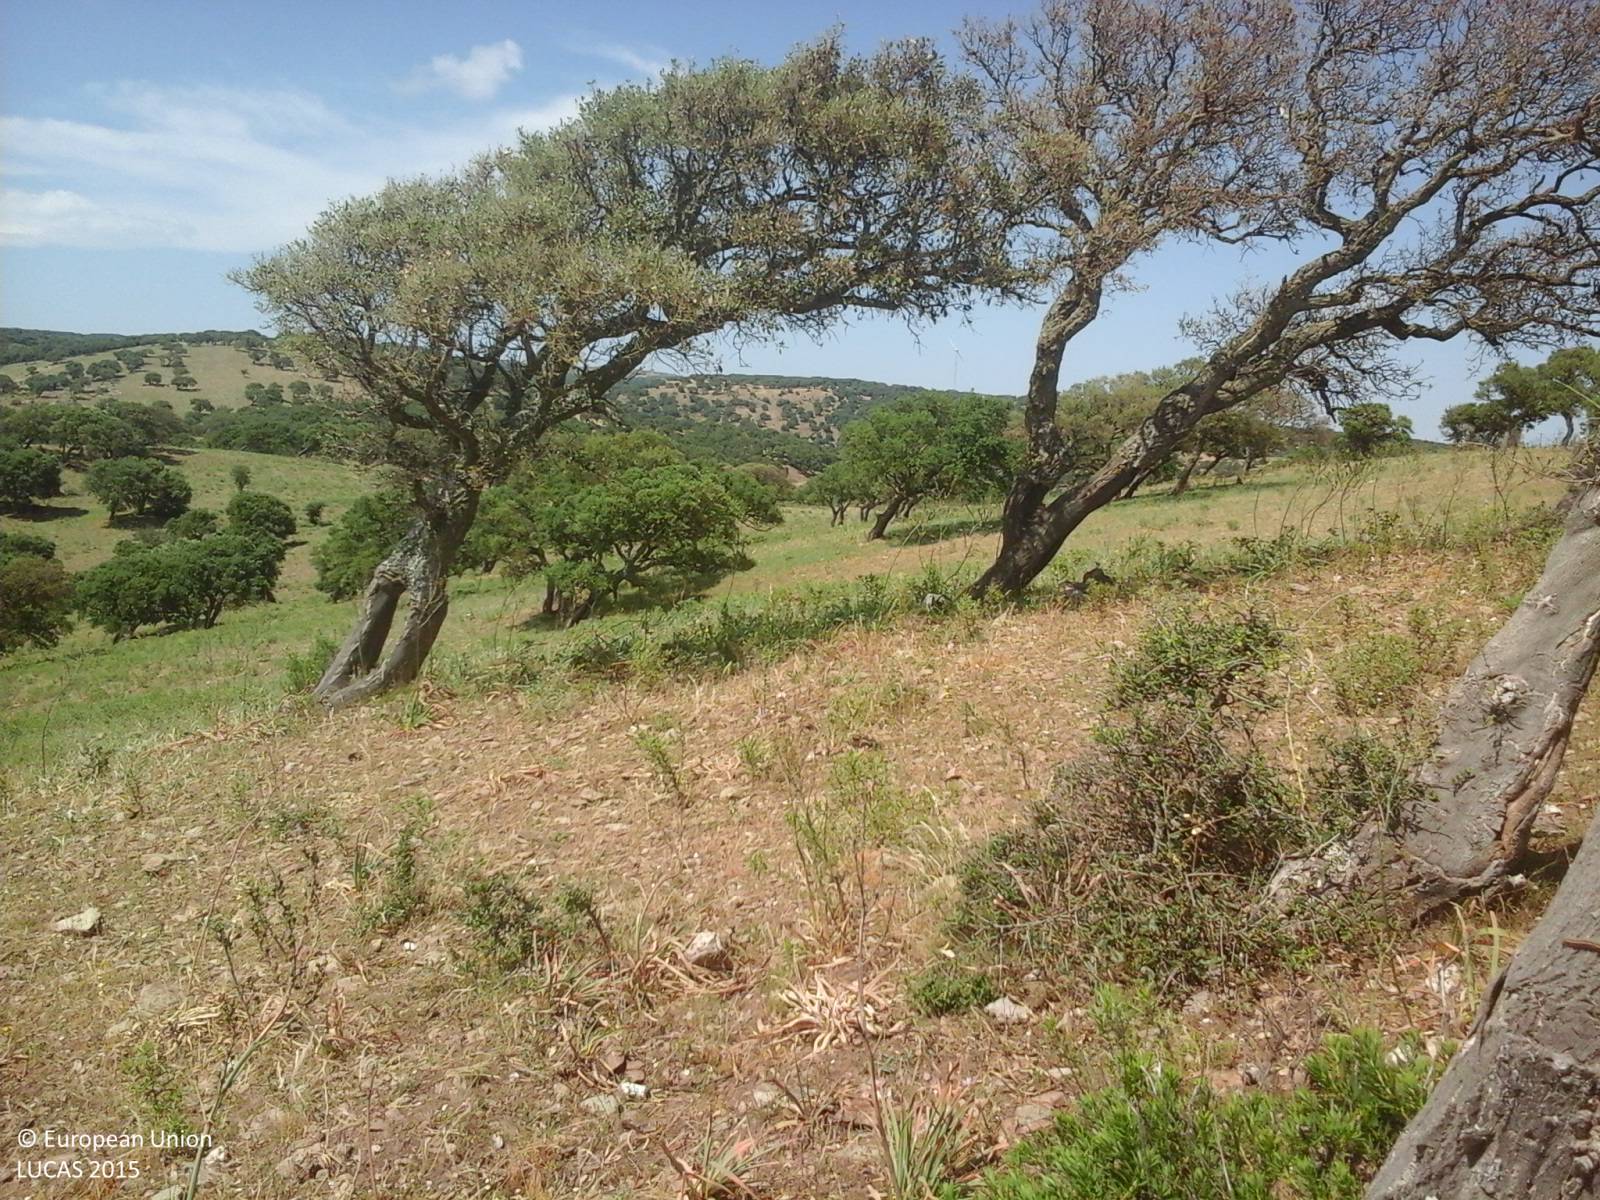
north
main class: Woodland
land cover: Broadleaved woodland
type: broadleaved evergreen forest
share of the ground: 25 - 50 %
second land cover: Spontaneously vegetated surfaces
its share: 25 - 50 %
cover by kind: broadleaved forest trees 90 %, herbaceous plants 5 %, unconsolidated bare surface 5 %
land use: Forestry
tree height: > 5 m
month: June
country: IT
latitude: 40.5189
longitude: 9.4011
